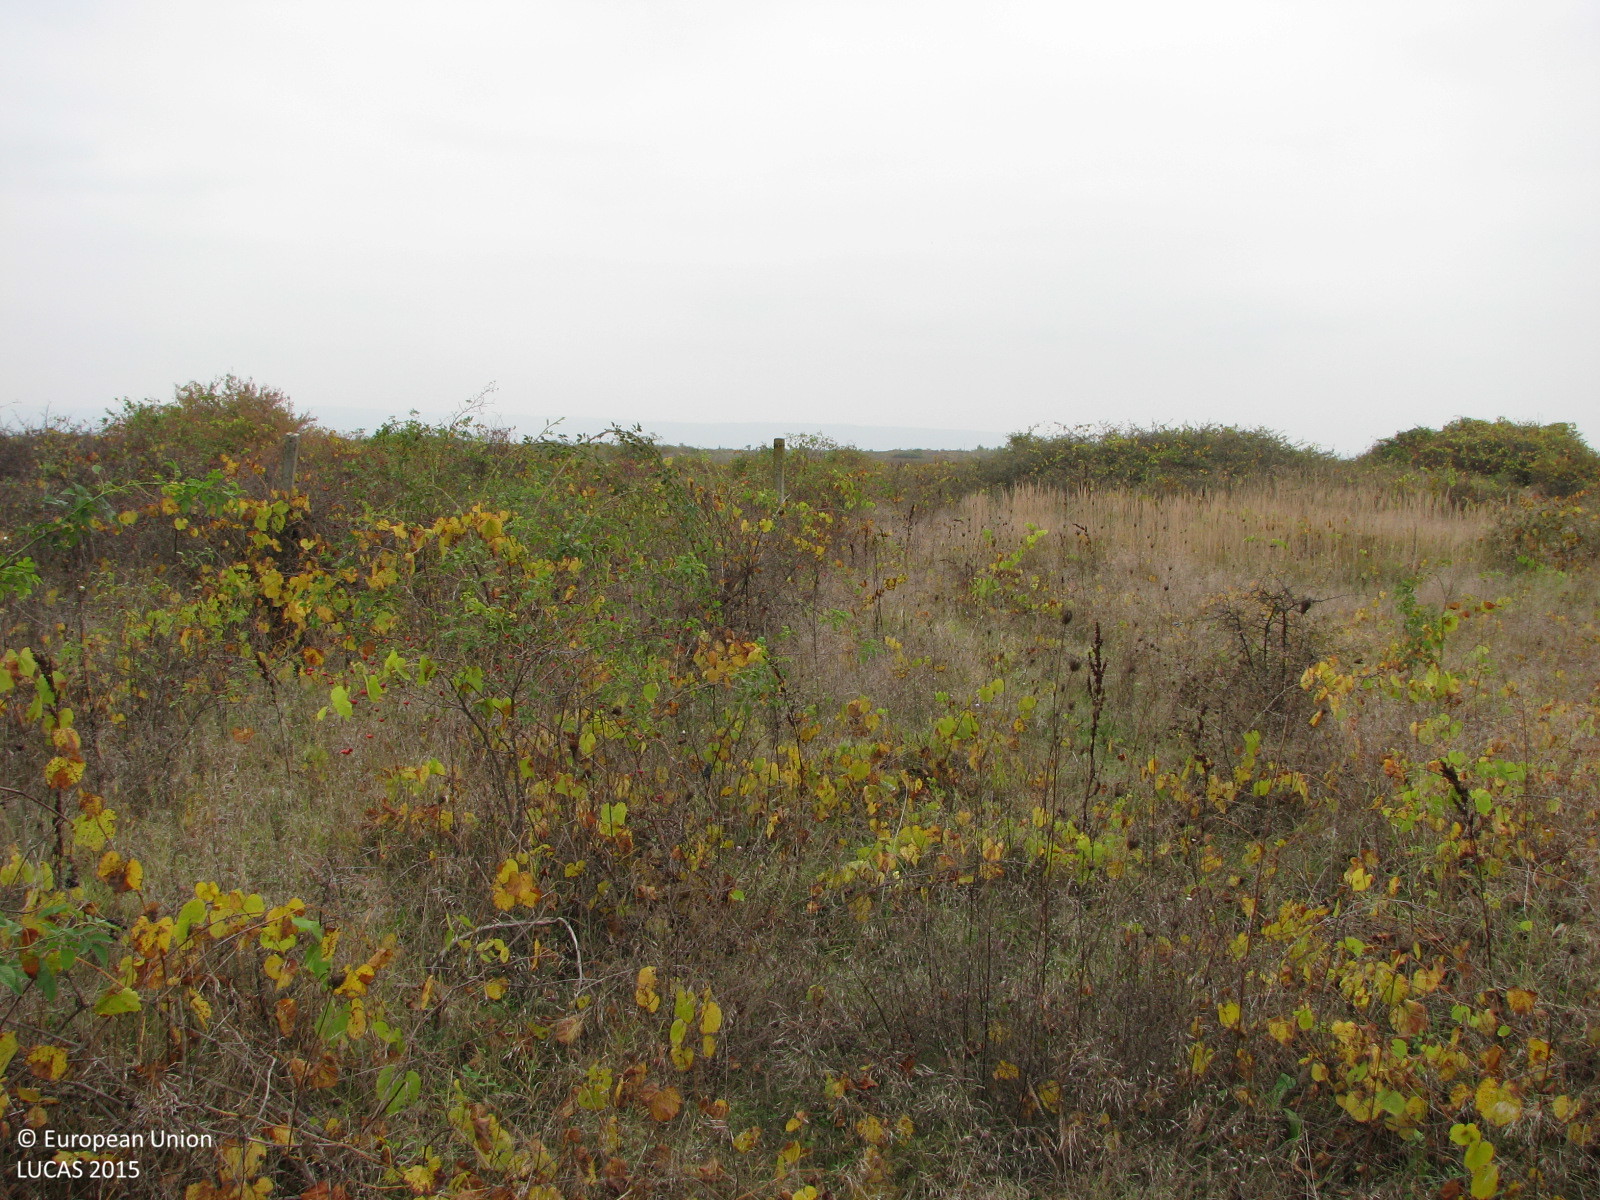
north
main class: Shrubland
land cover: Shrubland without tree cover
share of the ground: > 75 %
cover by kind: shrubs 80 %, herbaceous plants 20 %
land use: Semi-natural and natural areas not in use
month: October
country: BG
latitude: 42.5760
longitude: 26.7291
